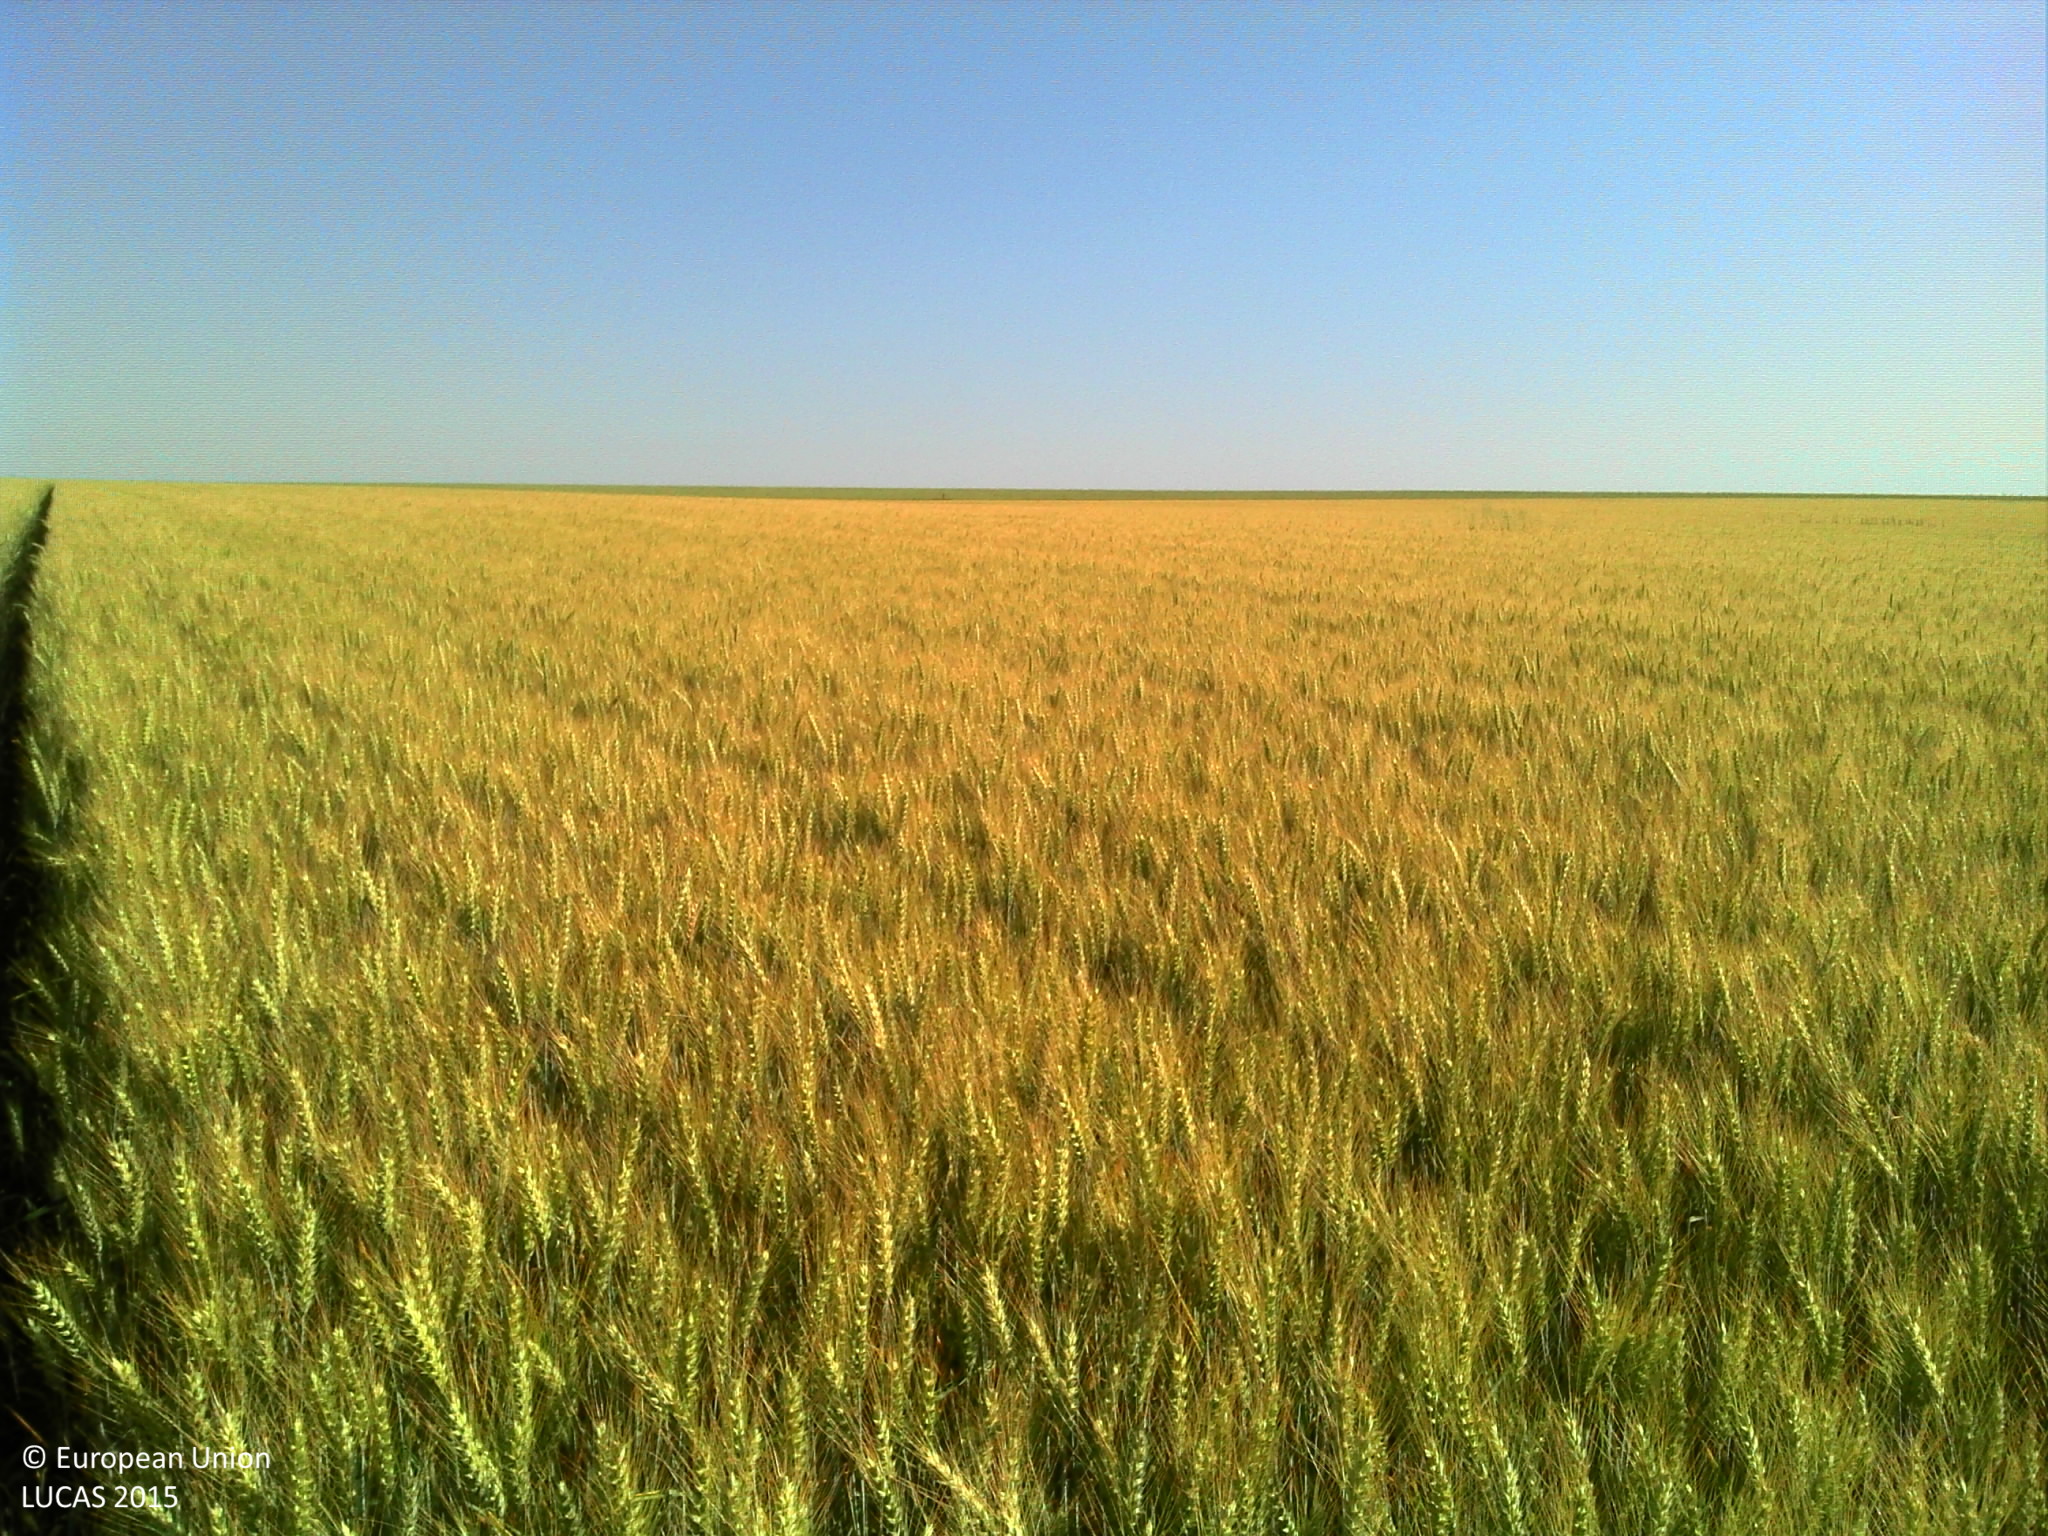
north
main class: Cropland
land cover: Common wheat
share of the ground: > 75 %
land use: Agriculture (excluding fallow land and kitchen gardens)
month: June
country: FR
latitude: 47.1073
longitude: 2.6010
